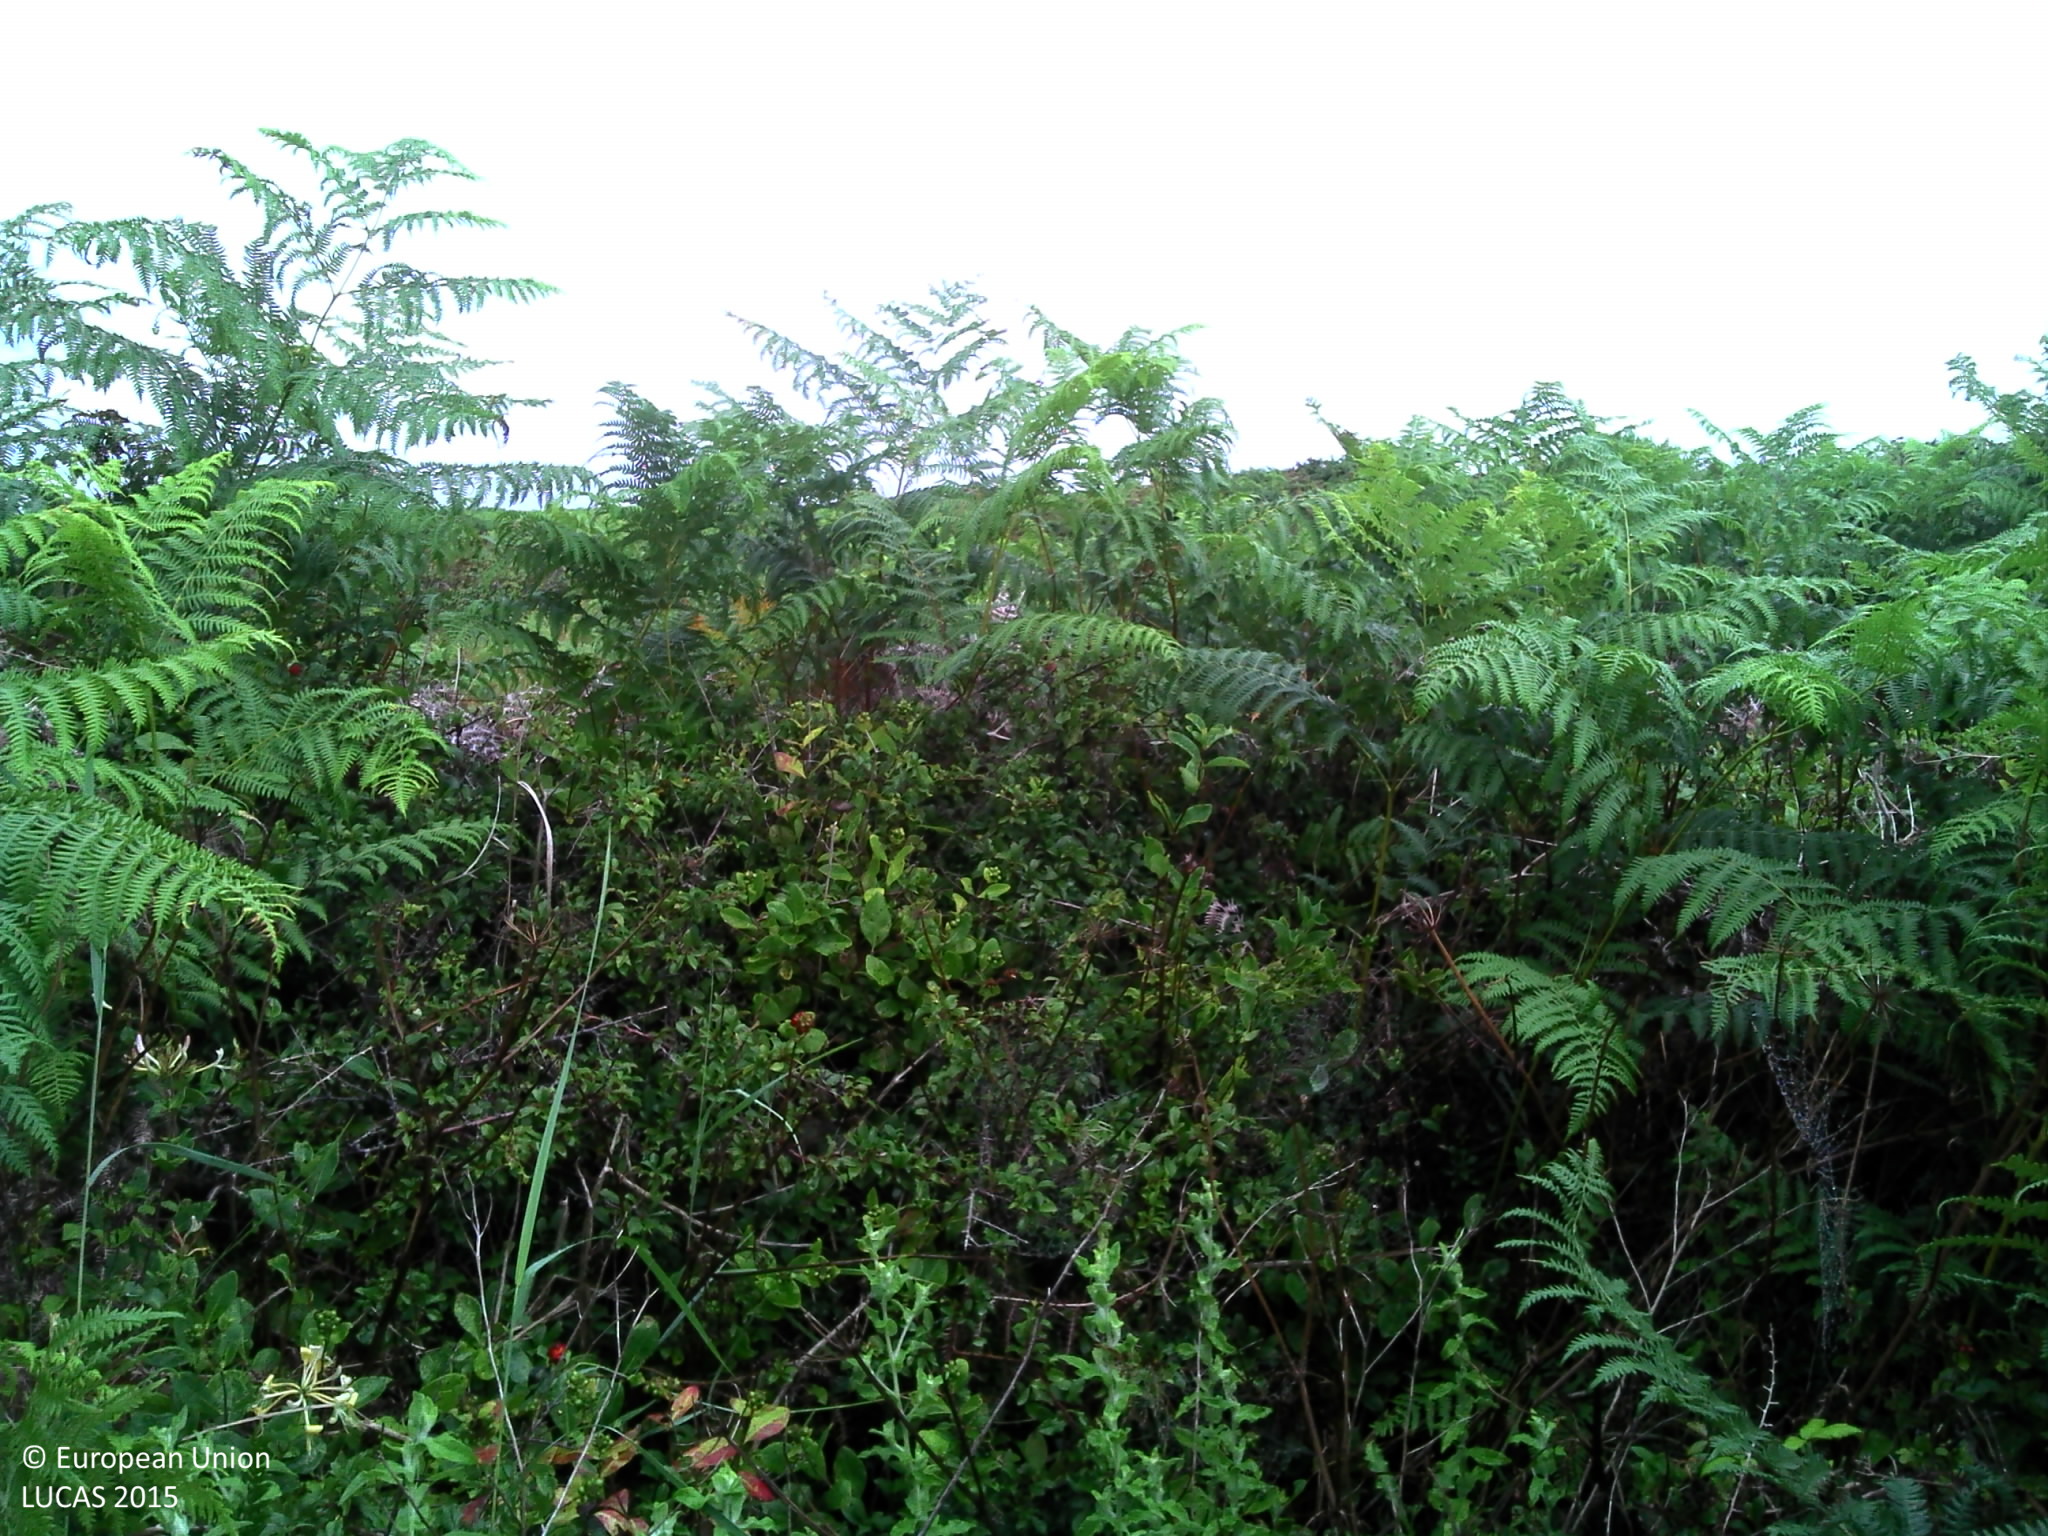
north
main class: Shrubland
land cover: Shrubland without tree cover
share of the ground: > 75 %
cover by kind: shrubs 60 %, herbaceous plants 30 %, consolidated bare surface 10 %
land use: Semi-natural and natural areas not in use
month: July
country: FR
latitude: 47.5052
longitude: -3.1449
